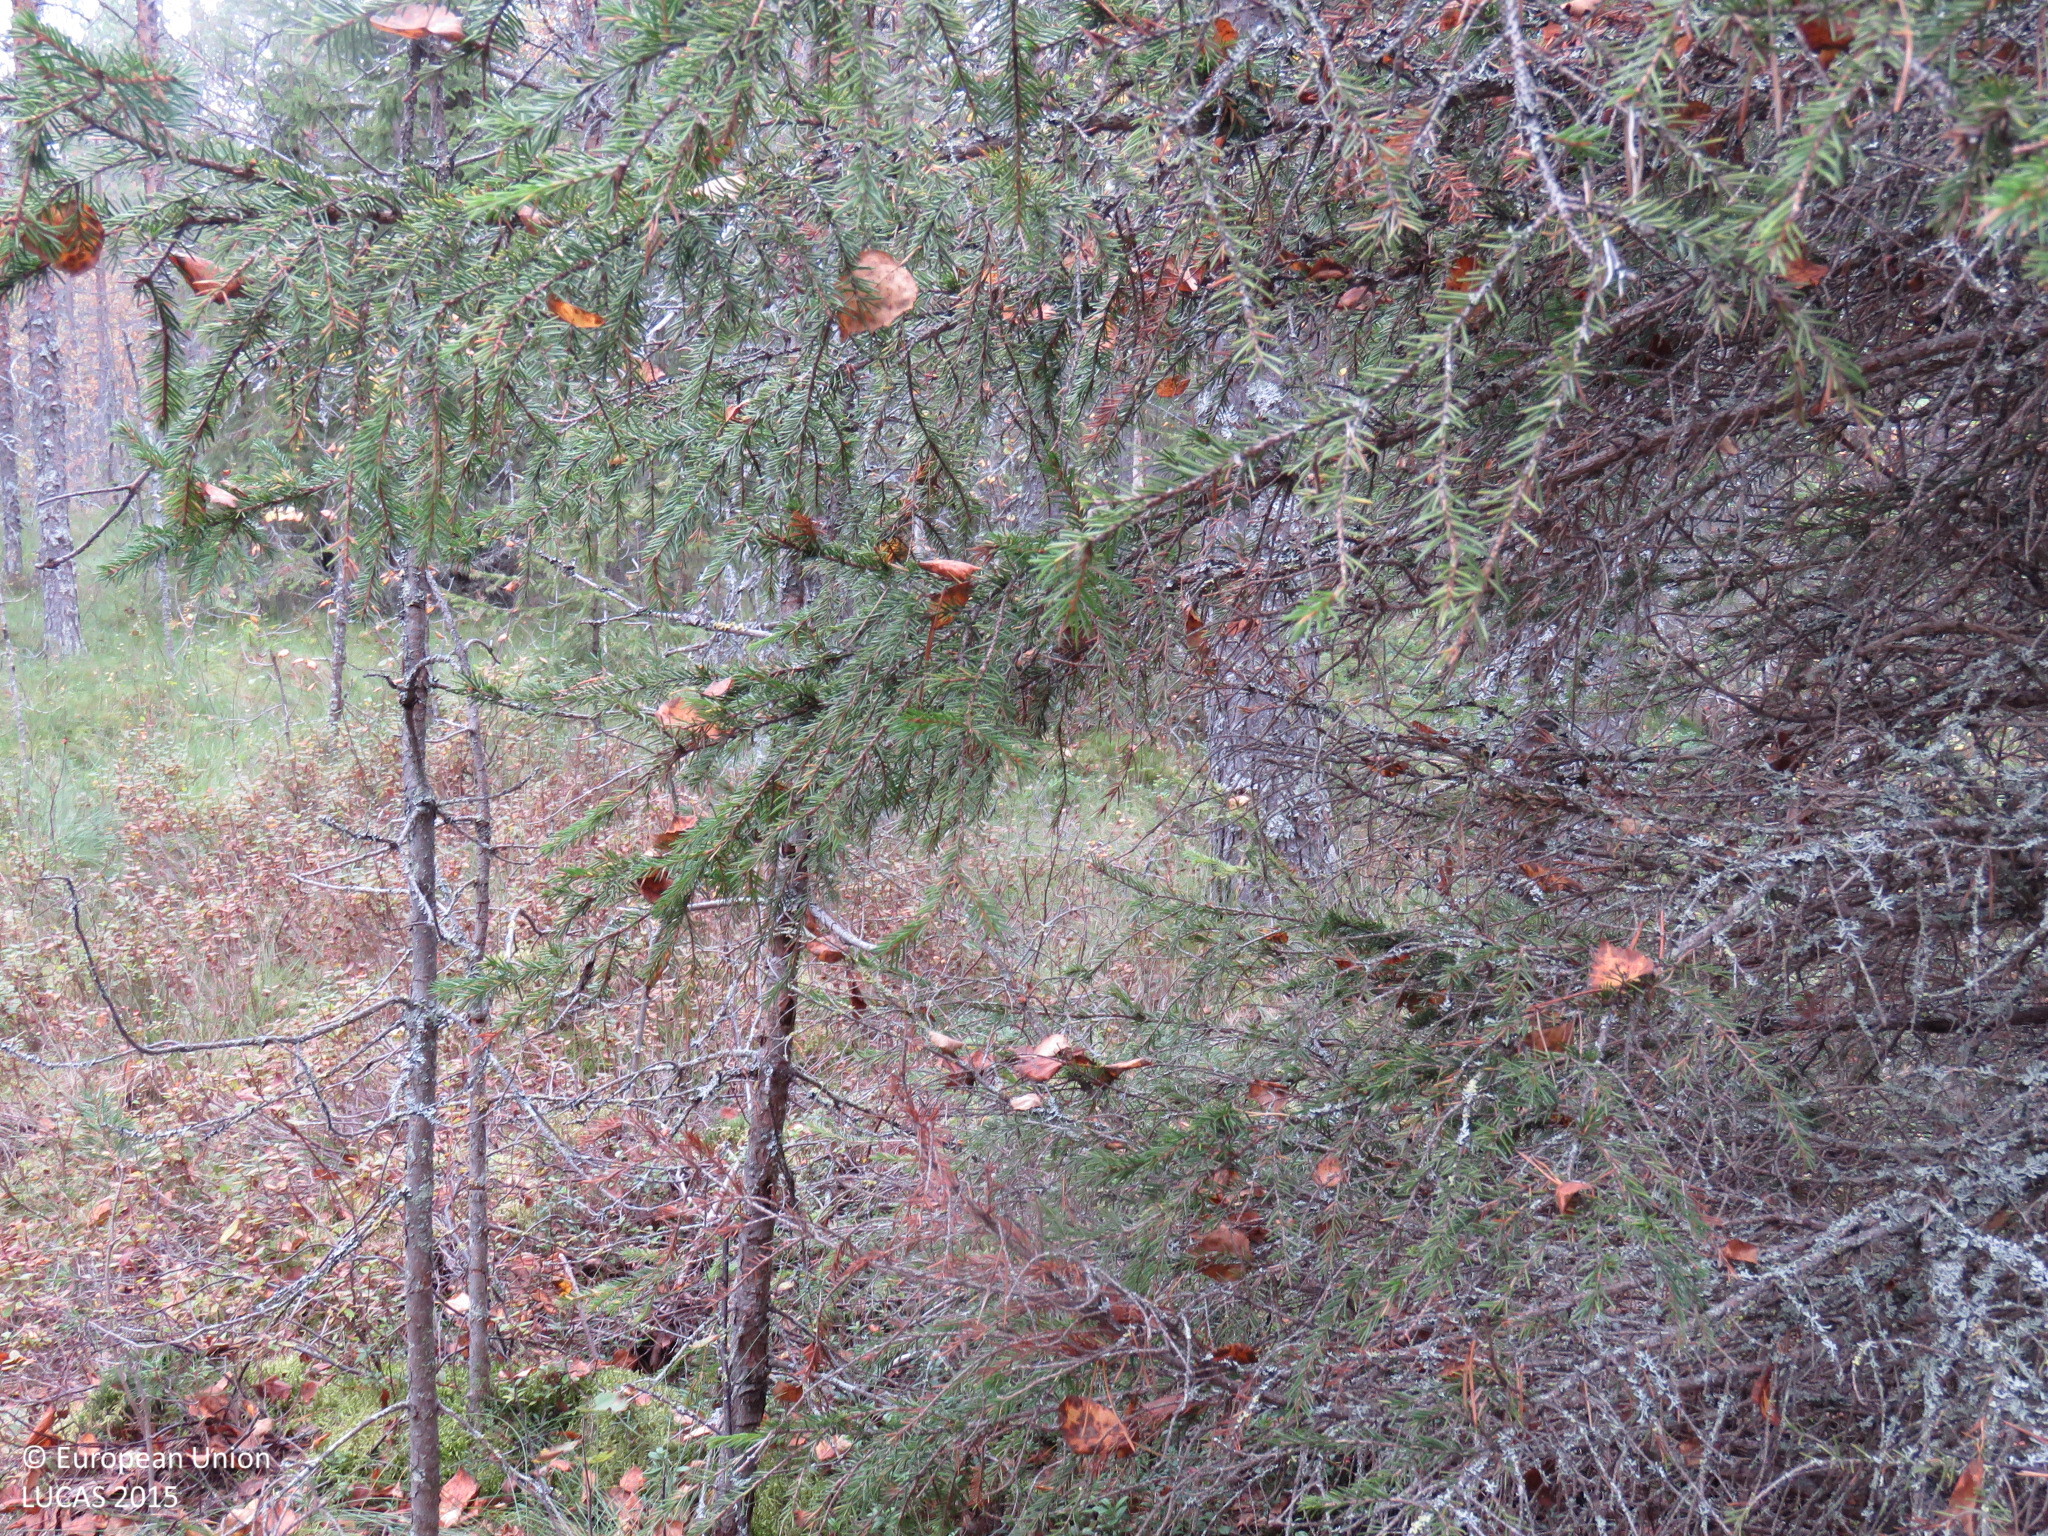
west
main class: Woodland
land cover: Other coniferous woodland
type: mire and swamp forests
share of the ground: > 75 %
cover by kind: coniferous forest trees 60 %, broadleaved forest trees 15 %, shrubs 10 %, herbaceous plants 10 %, lichens and mosses 5 %
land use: Forestry
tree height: > 5 m
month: September
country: FI
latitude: 64.9223
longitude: 26.9748
